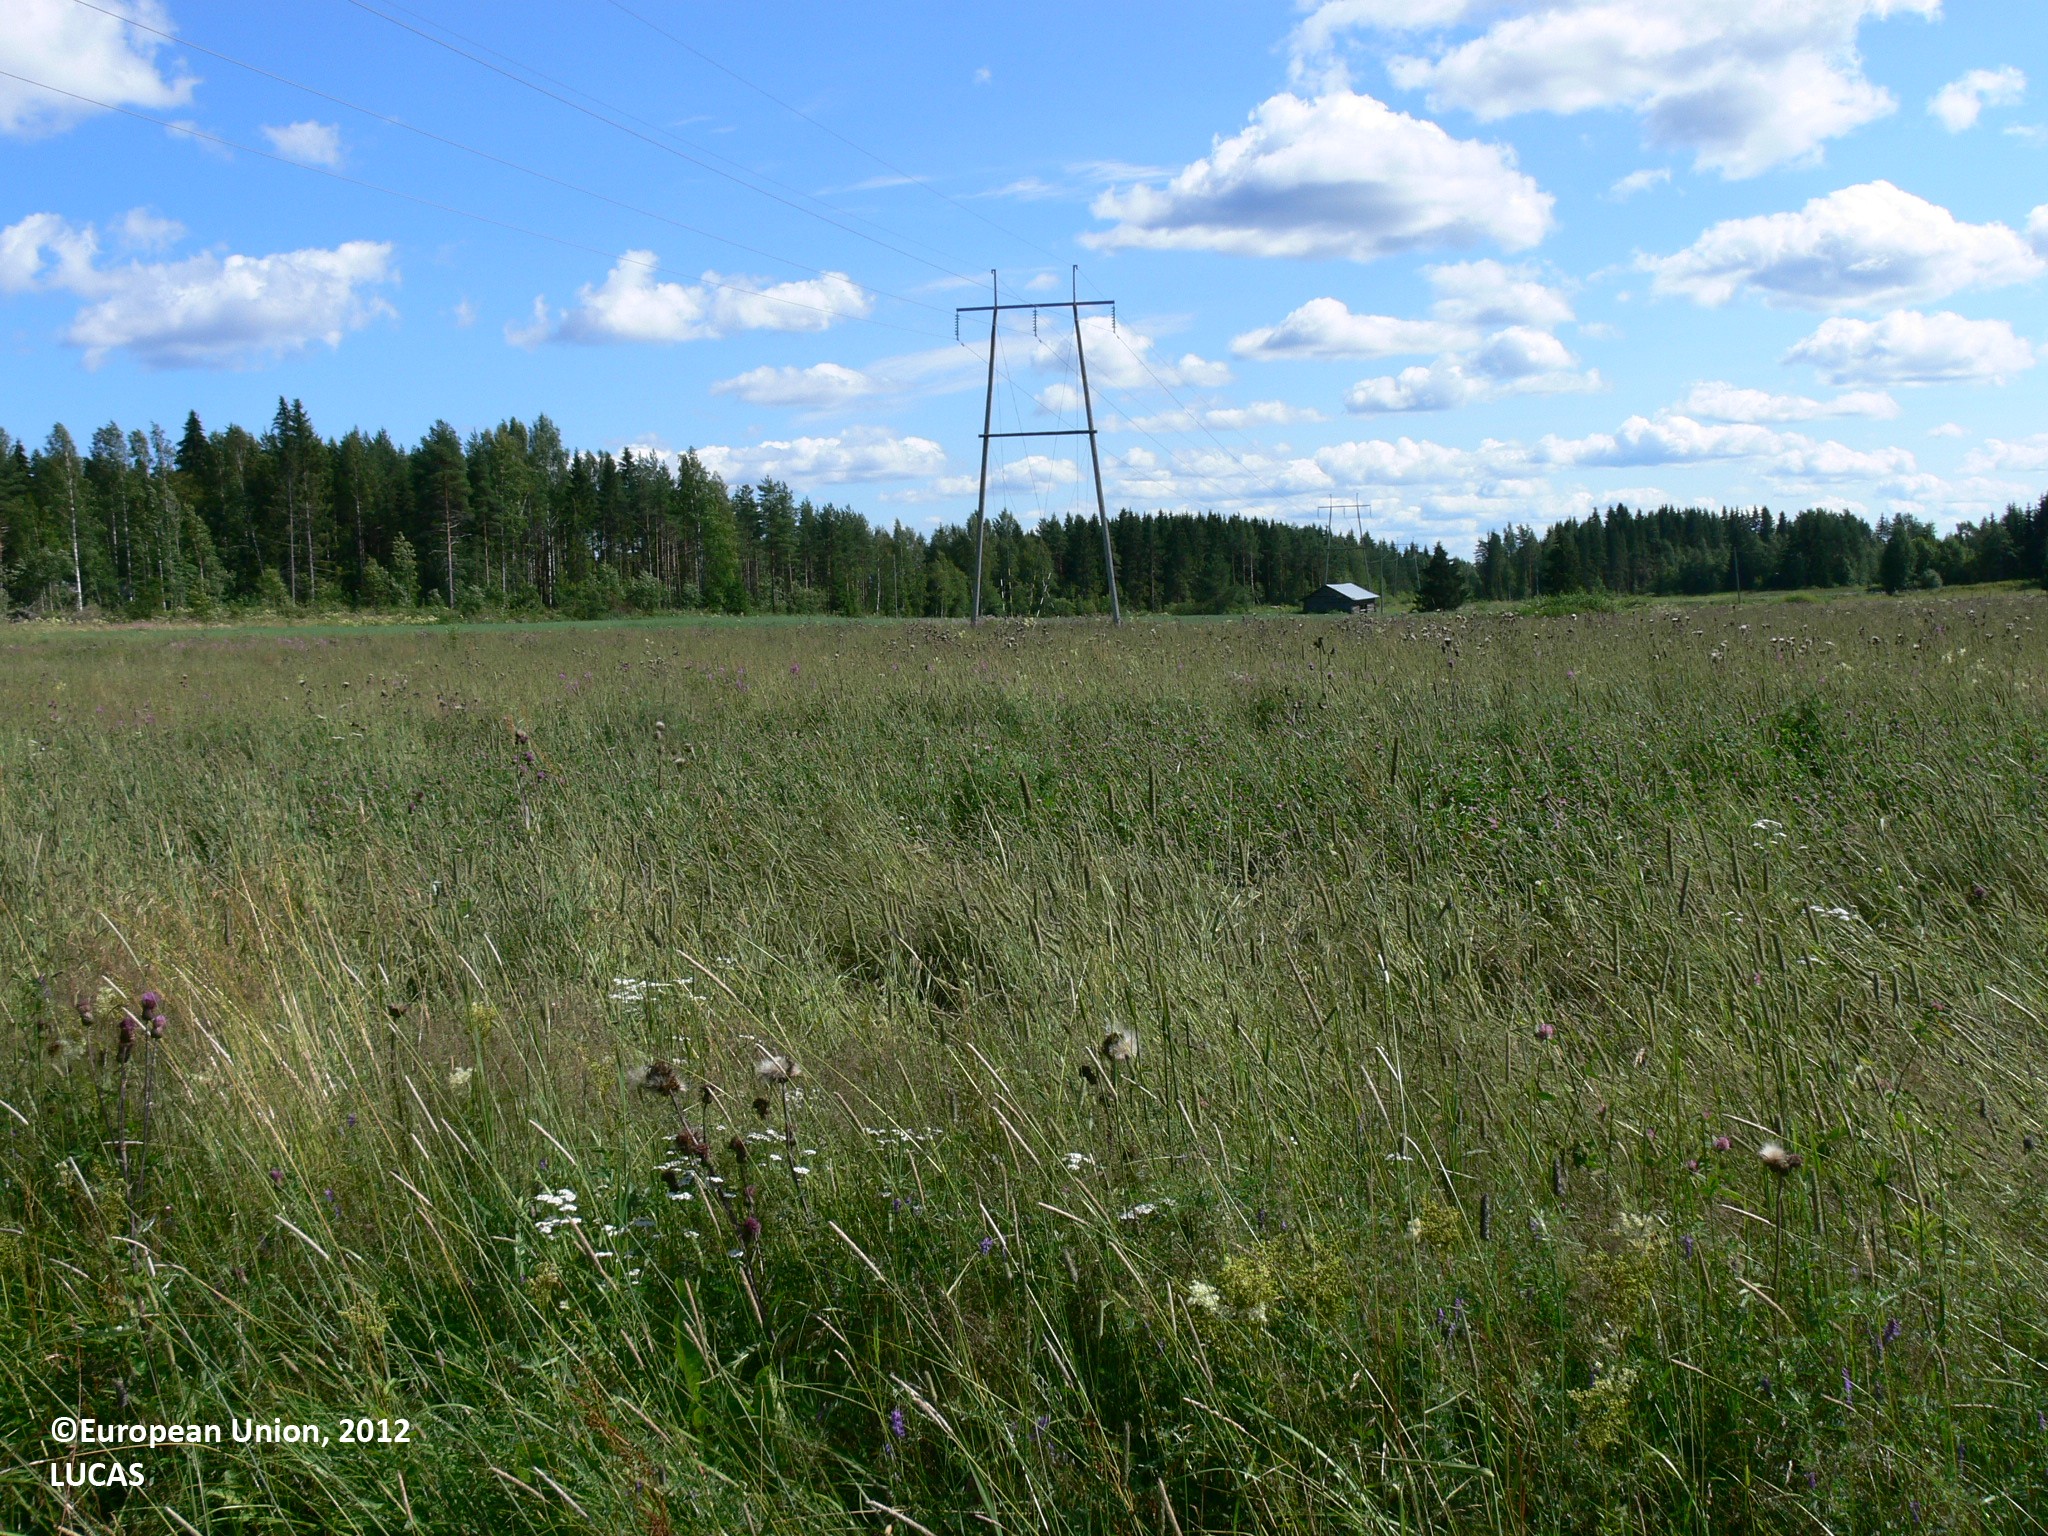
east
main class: Cropland
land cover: Temporary grasslands
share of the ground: > 75 %
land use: Agriculture (excluding fallow land and kitchen gardens)
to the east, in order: Temporary grasslands; Ditches and canals; Spontaneously vegetated surfaces; Electric lines; Spontaneously vegetated surfaces; Ditches and canals; Spontaneously vegetated surfaces; Ditches and canals; Spontaneously vegetated surfaces; Ditches and canals; Spontaneously vegetated surfaces; Ditches and canals; Spontaneously vegetated surfaces; Ditches and canals; Broadleaved woodland; Artificial constructions in urban areas
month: July
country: FI
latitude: 63.2570
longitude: 29.2426
